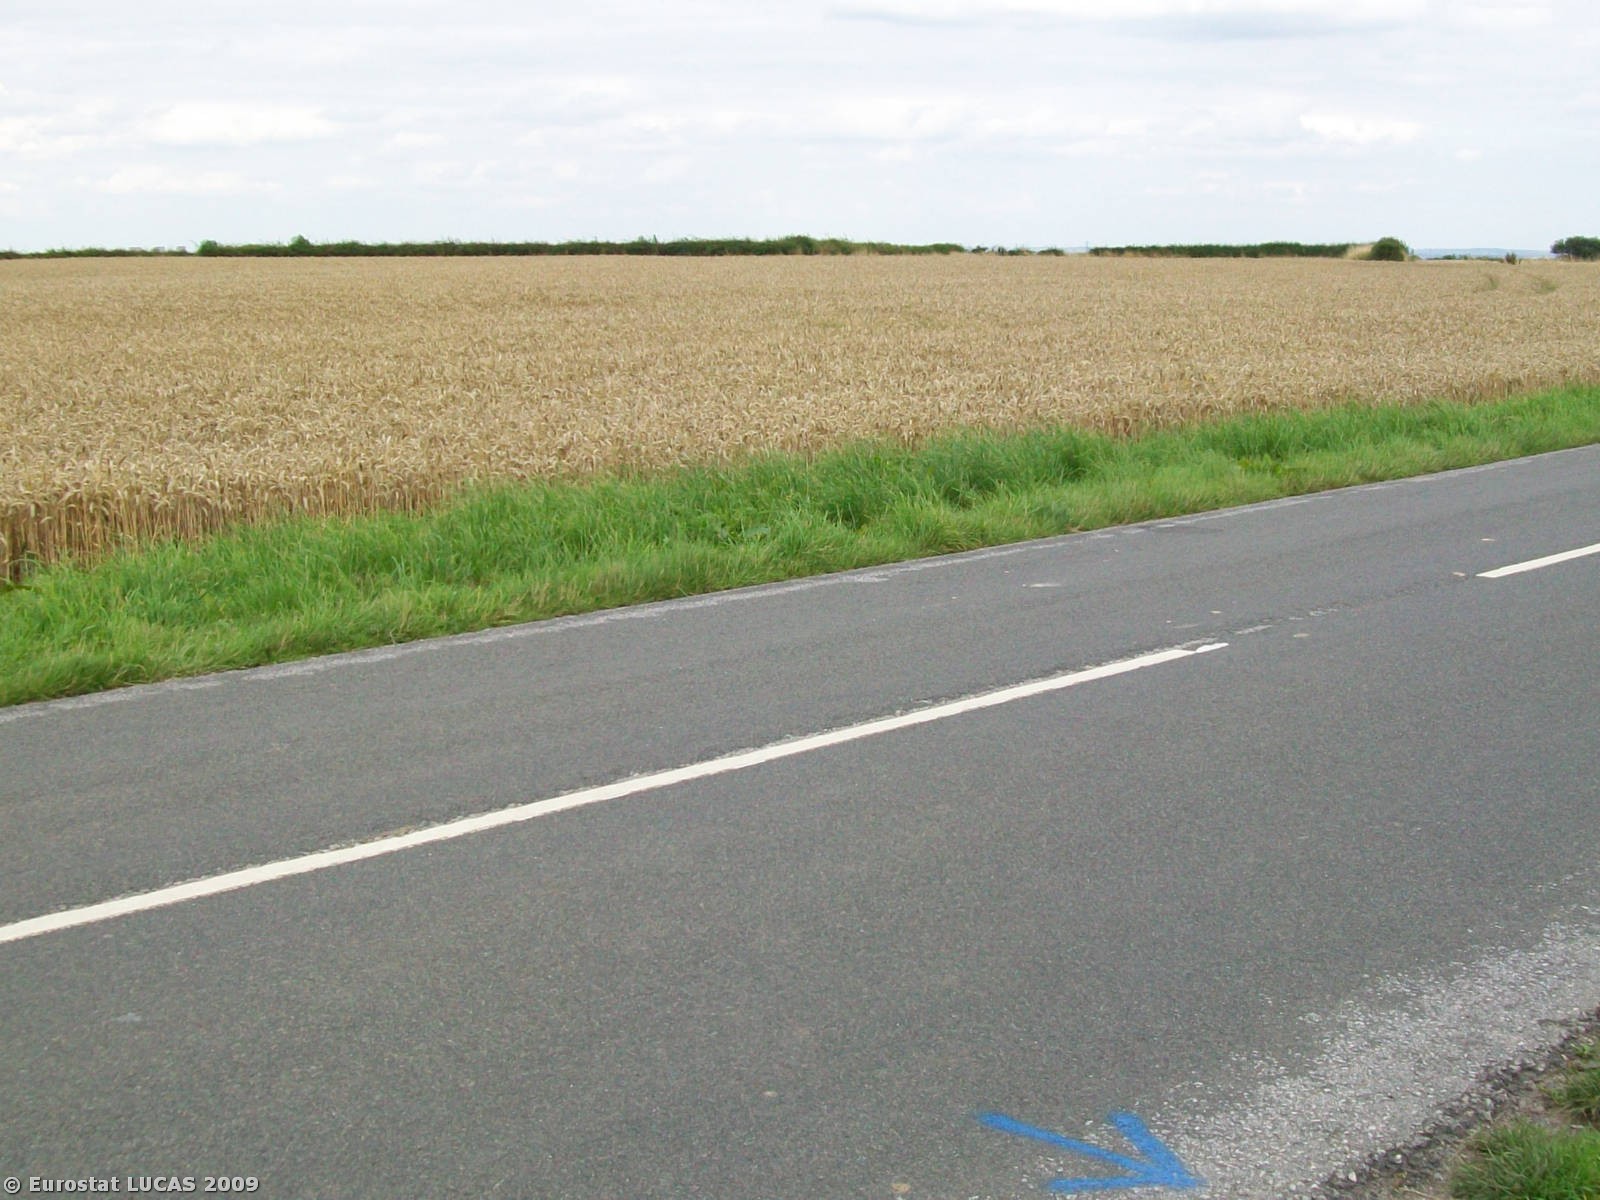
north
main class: Cropland
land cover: Common wheat
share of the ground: > 75 %
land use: Agriculture (excluding fallow land and kitchen gardens)
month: August
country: GB
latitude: 53.1937
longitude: -0.9546
